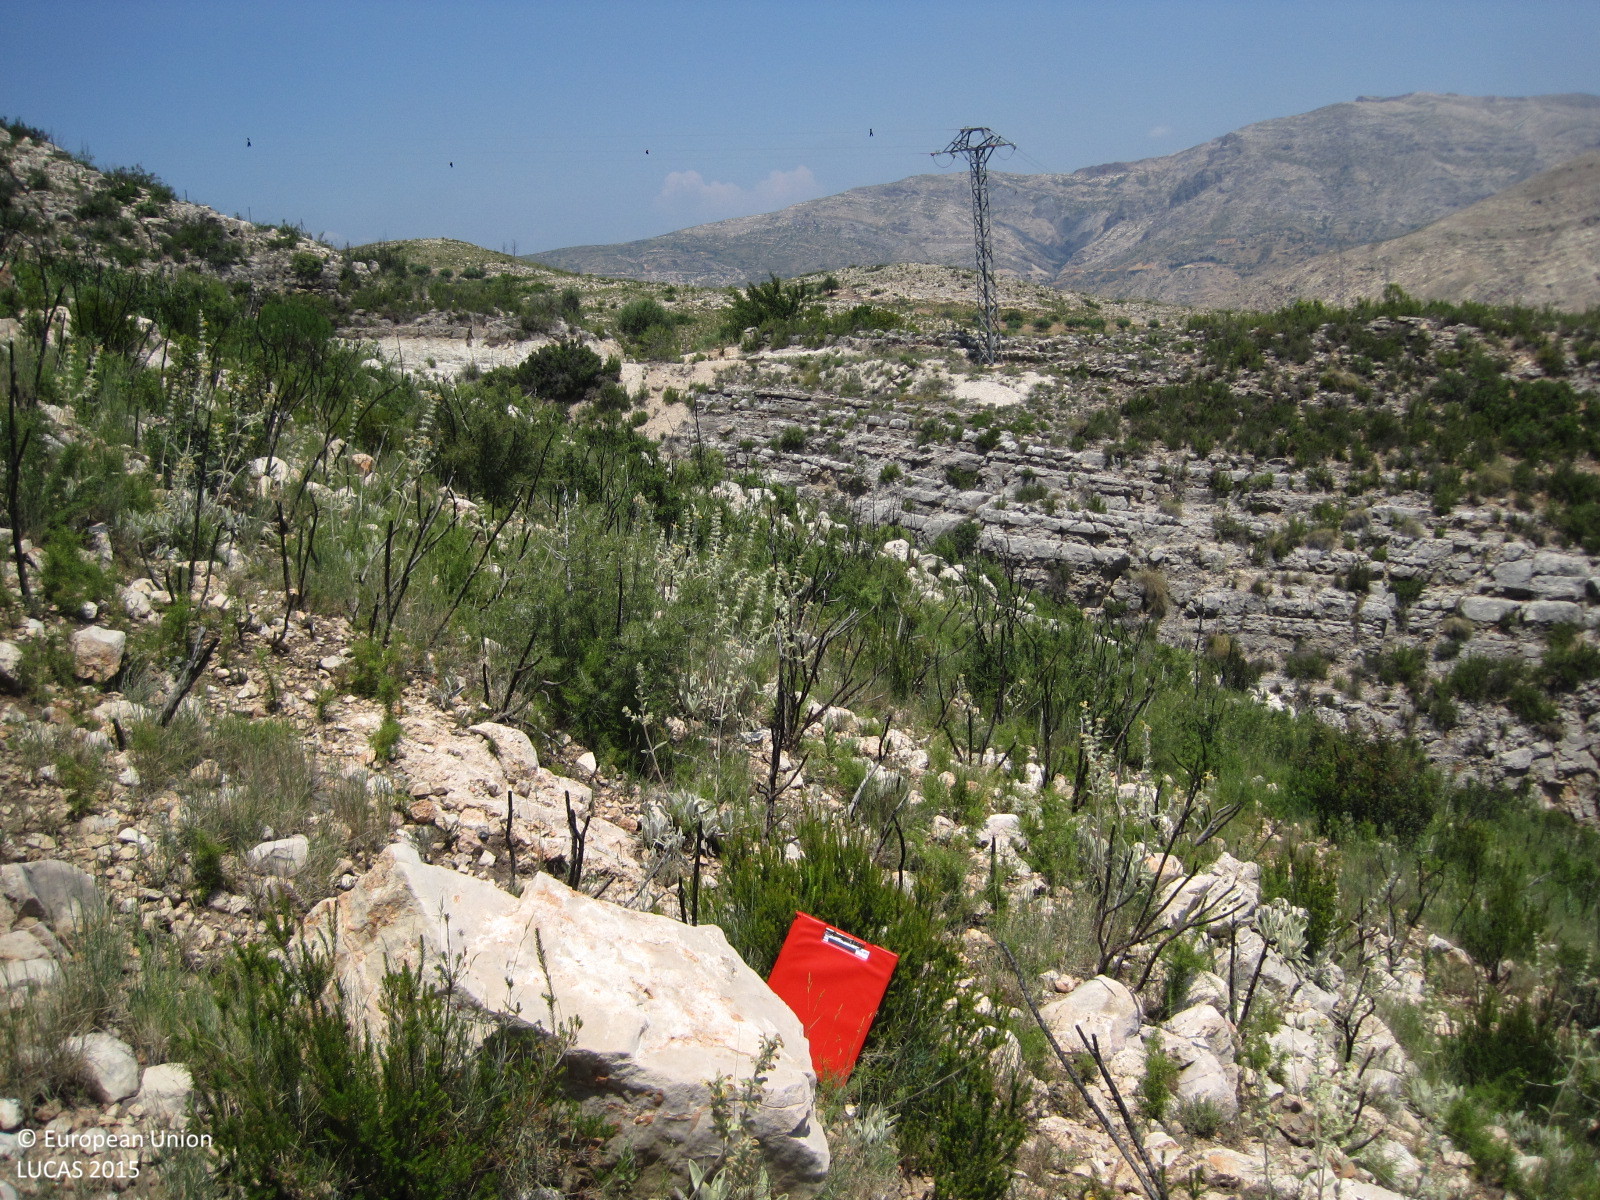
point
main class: Shrubland
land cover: Shrubland without tree cover
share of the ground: 50 - 75 %
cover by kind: shrubs 50 %, consolidated bare surface 35 %, herbaceous plants 15 %
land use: Semi-natural and natural areas not in use
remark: Burnt area
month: June
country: ES
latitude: 39.2642
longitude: -0.8338
